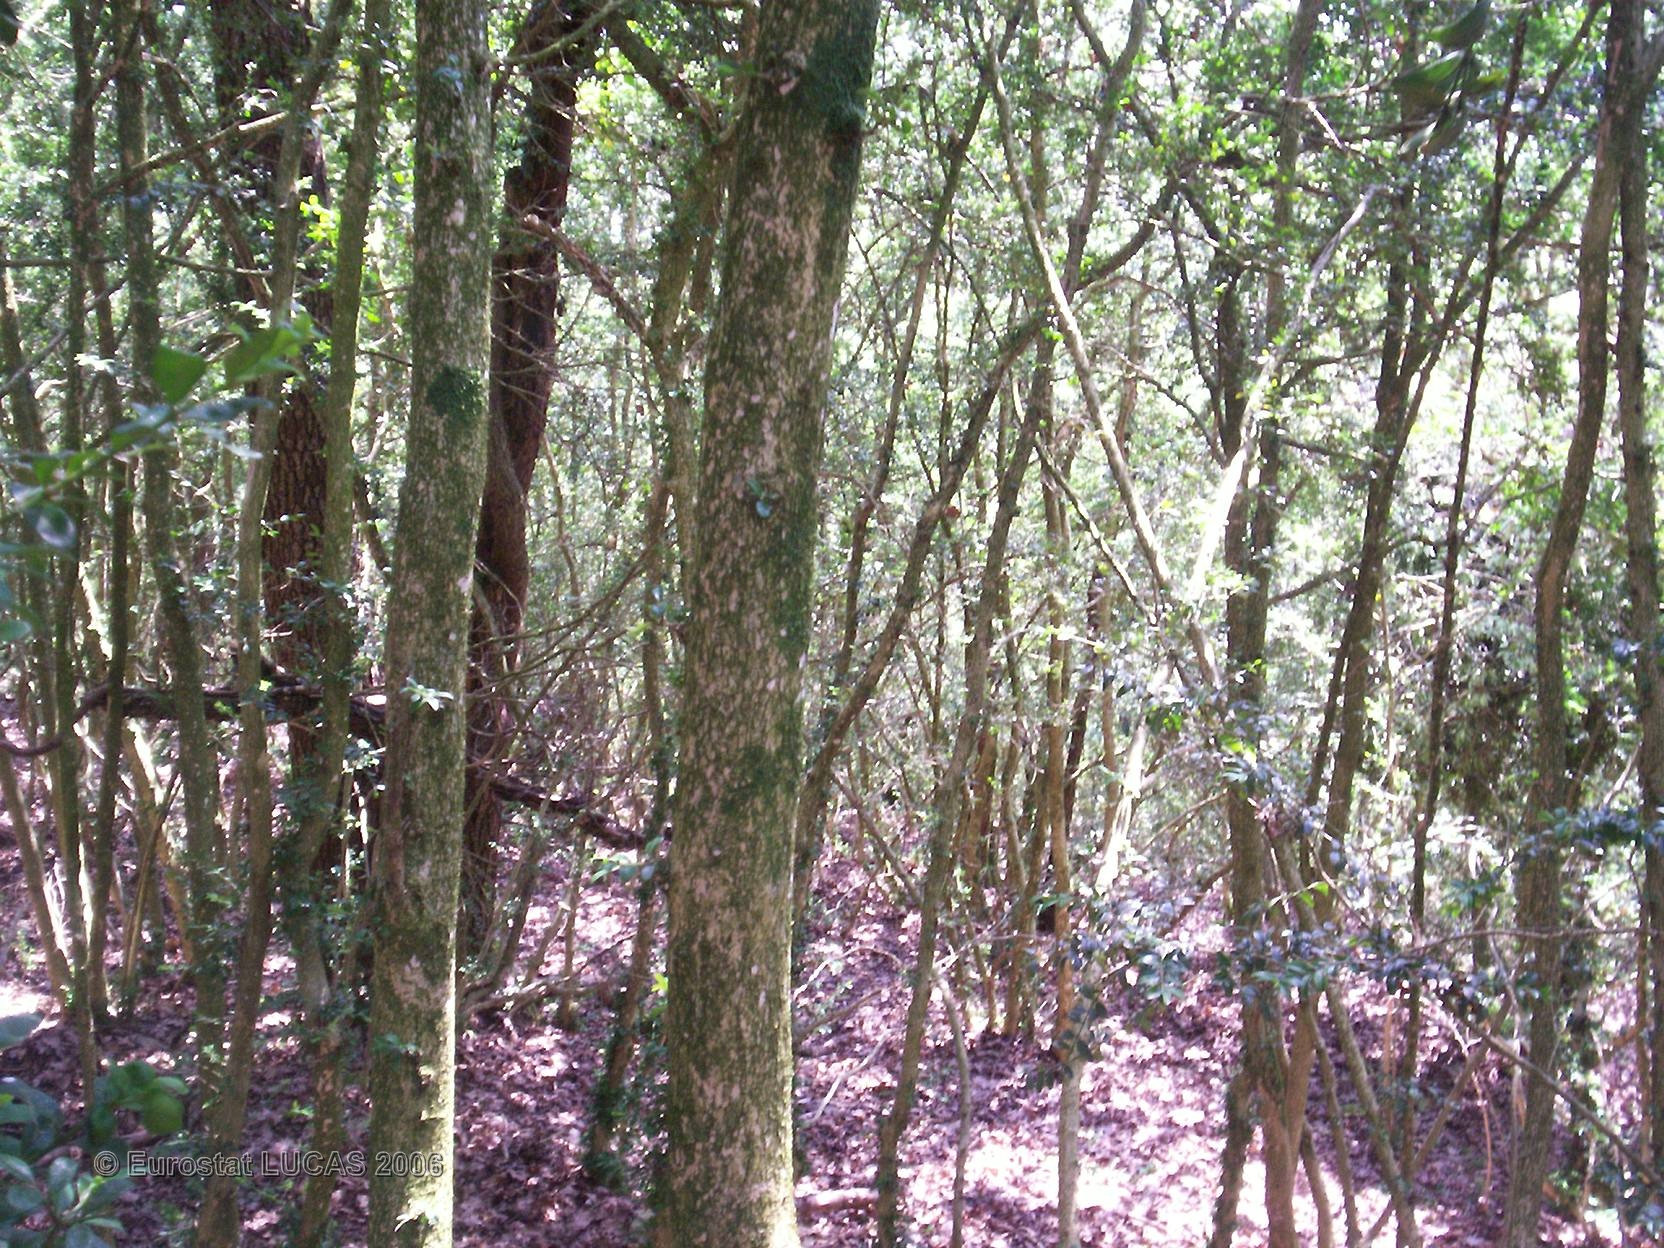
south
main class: Cropland
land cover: Barley
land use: Agriculture (excluding fallow land and kitchen gardens)
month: May
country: FR
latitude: 47.5125
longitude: 4.5684
